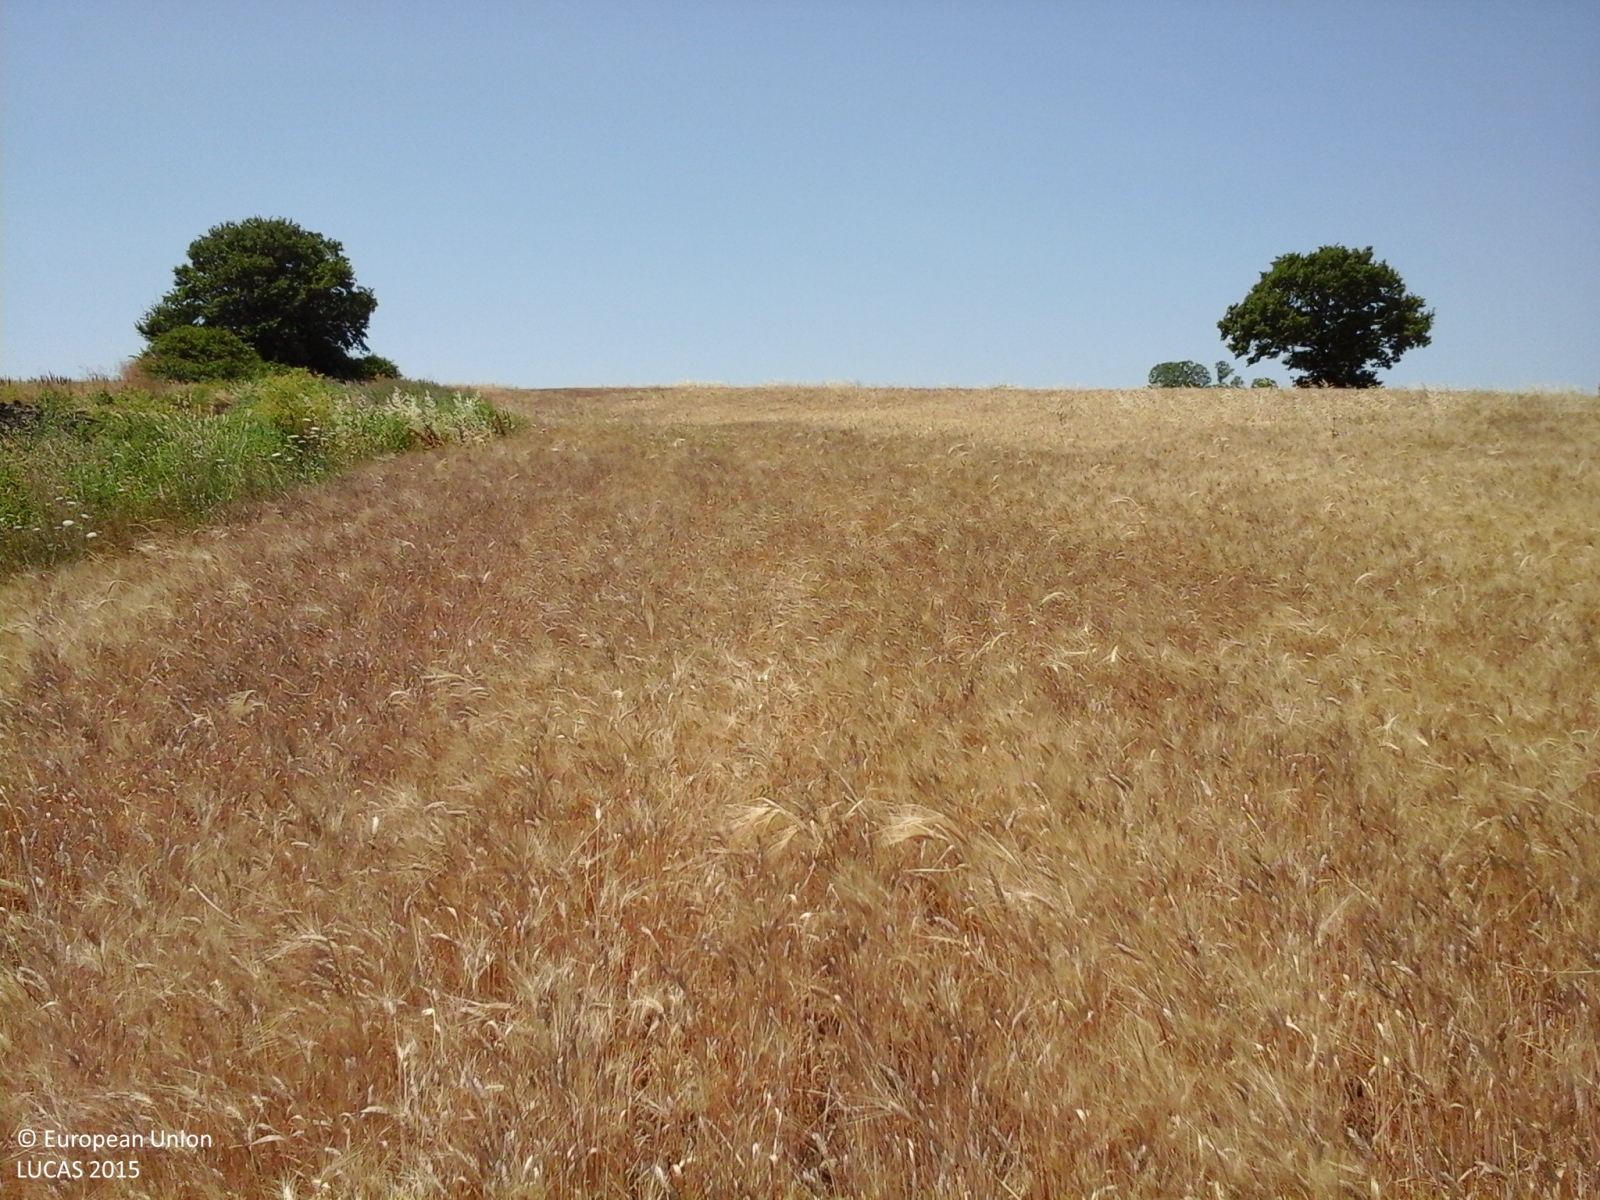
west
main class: Cropland
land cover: Durum wheat
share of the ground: > 75 %
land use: Agriculture (excluding fallow land and kitchen gardens)
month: July
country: IT
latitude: 41.6198
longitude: 14.7484
